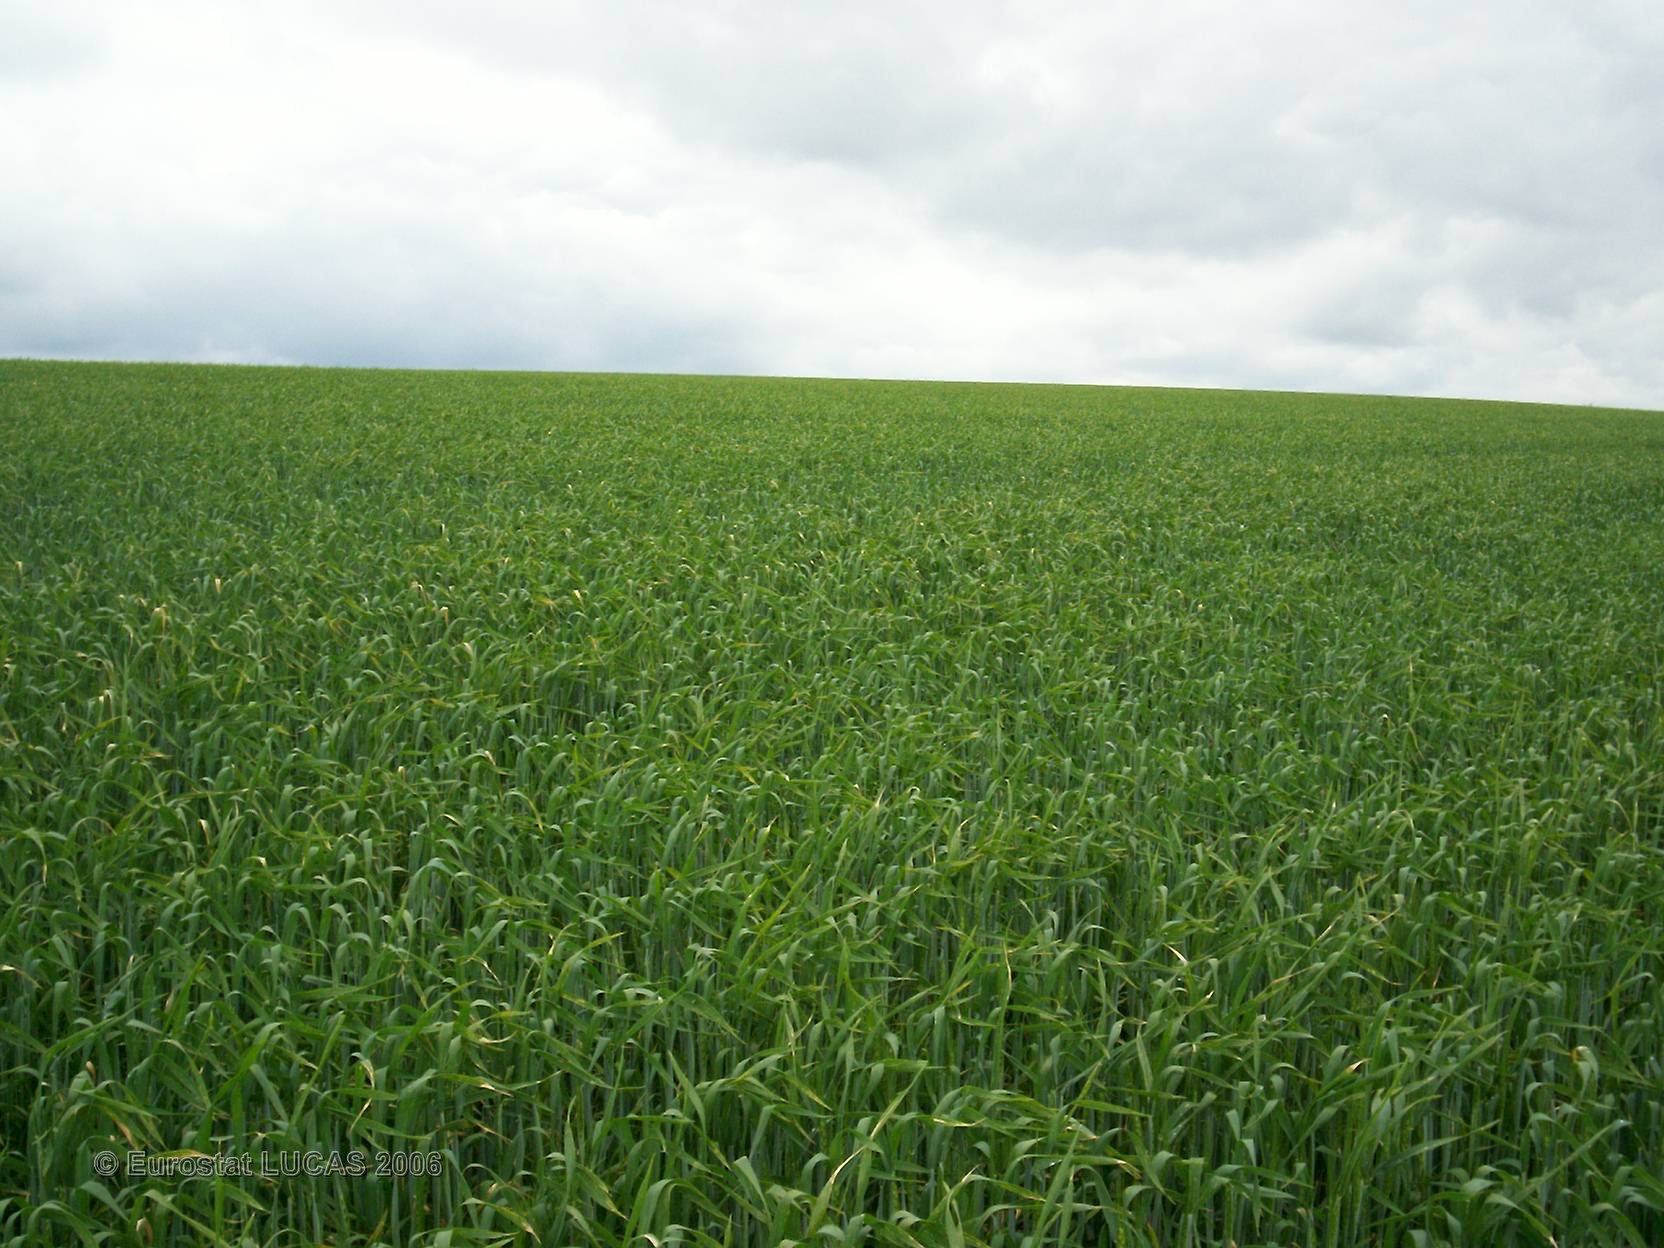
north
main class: Cropland
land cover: Common wheat
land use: Agriculture (excluding fallow land and kitchen gardens)
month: May
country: FR
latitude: 48.2507
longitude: 4.5432
